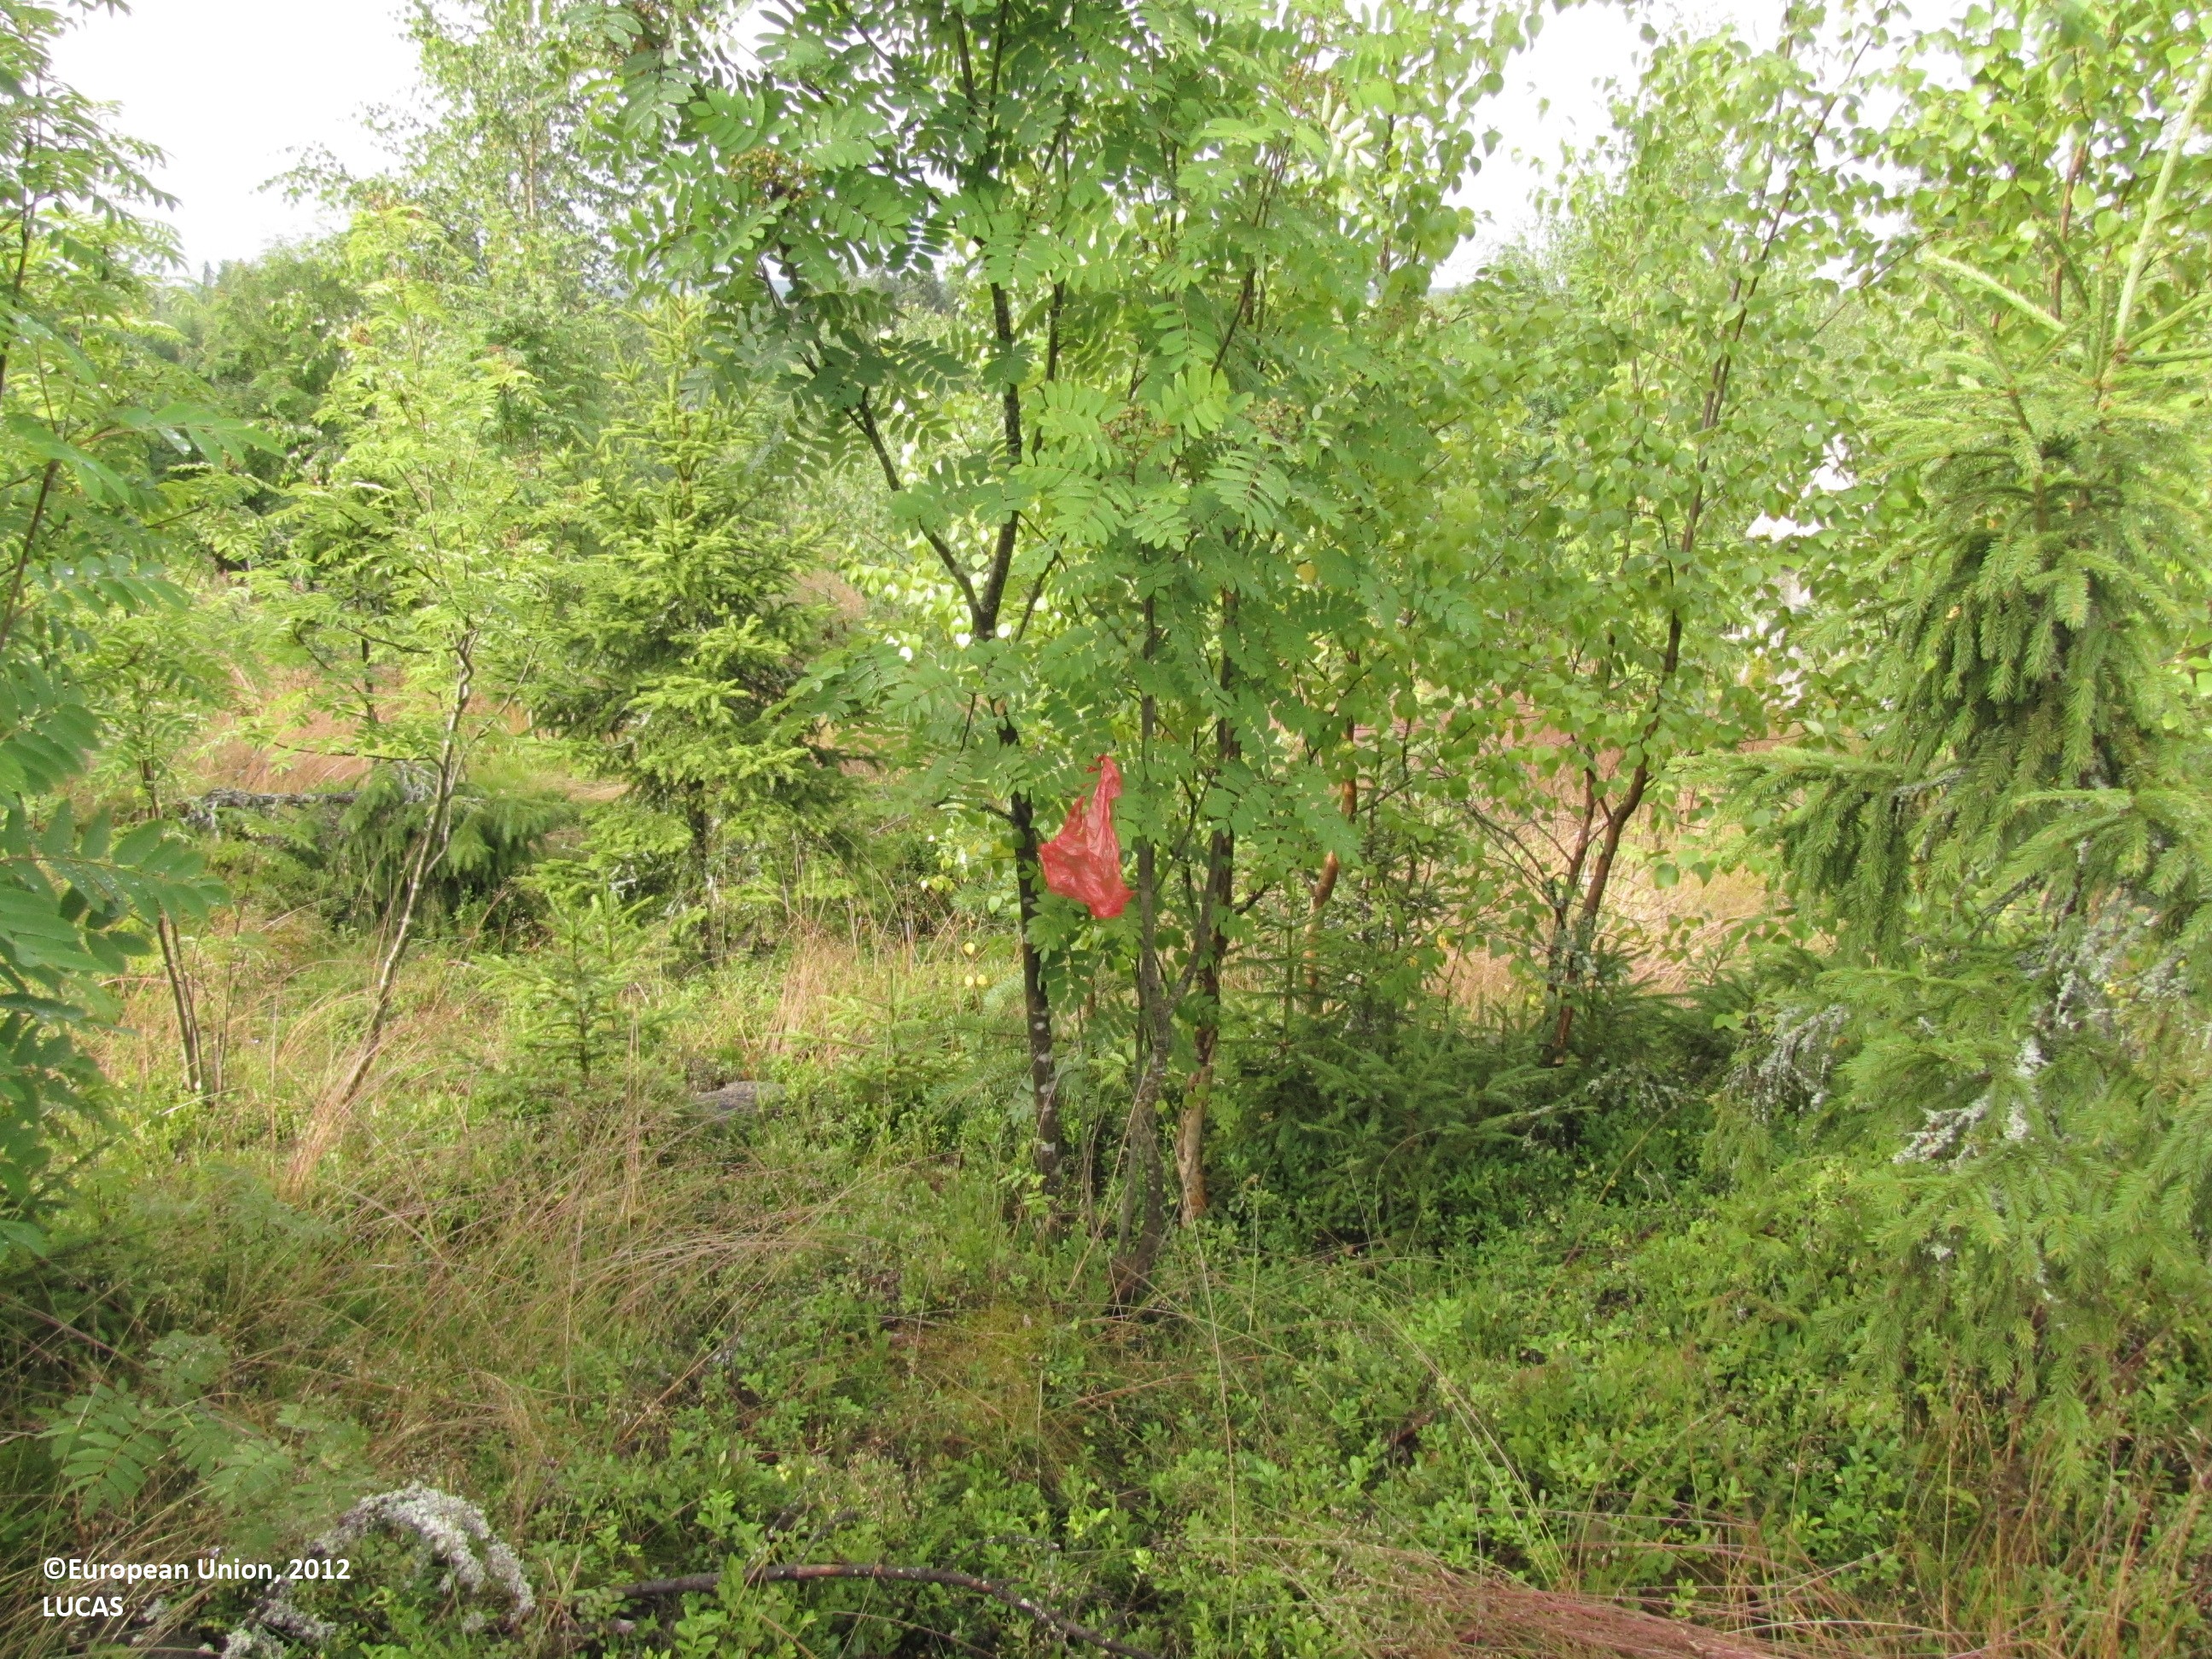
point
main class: Woodland
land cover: Broadleaved woodland
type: boreal forest
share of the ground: 50 - 75 %
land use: Forestry
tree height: < 5 m
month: July
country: FI
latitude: 62.1540
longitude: 23.0199
